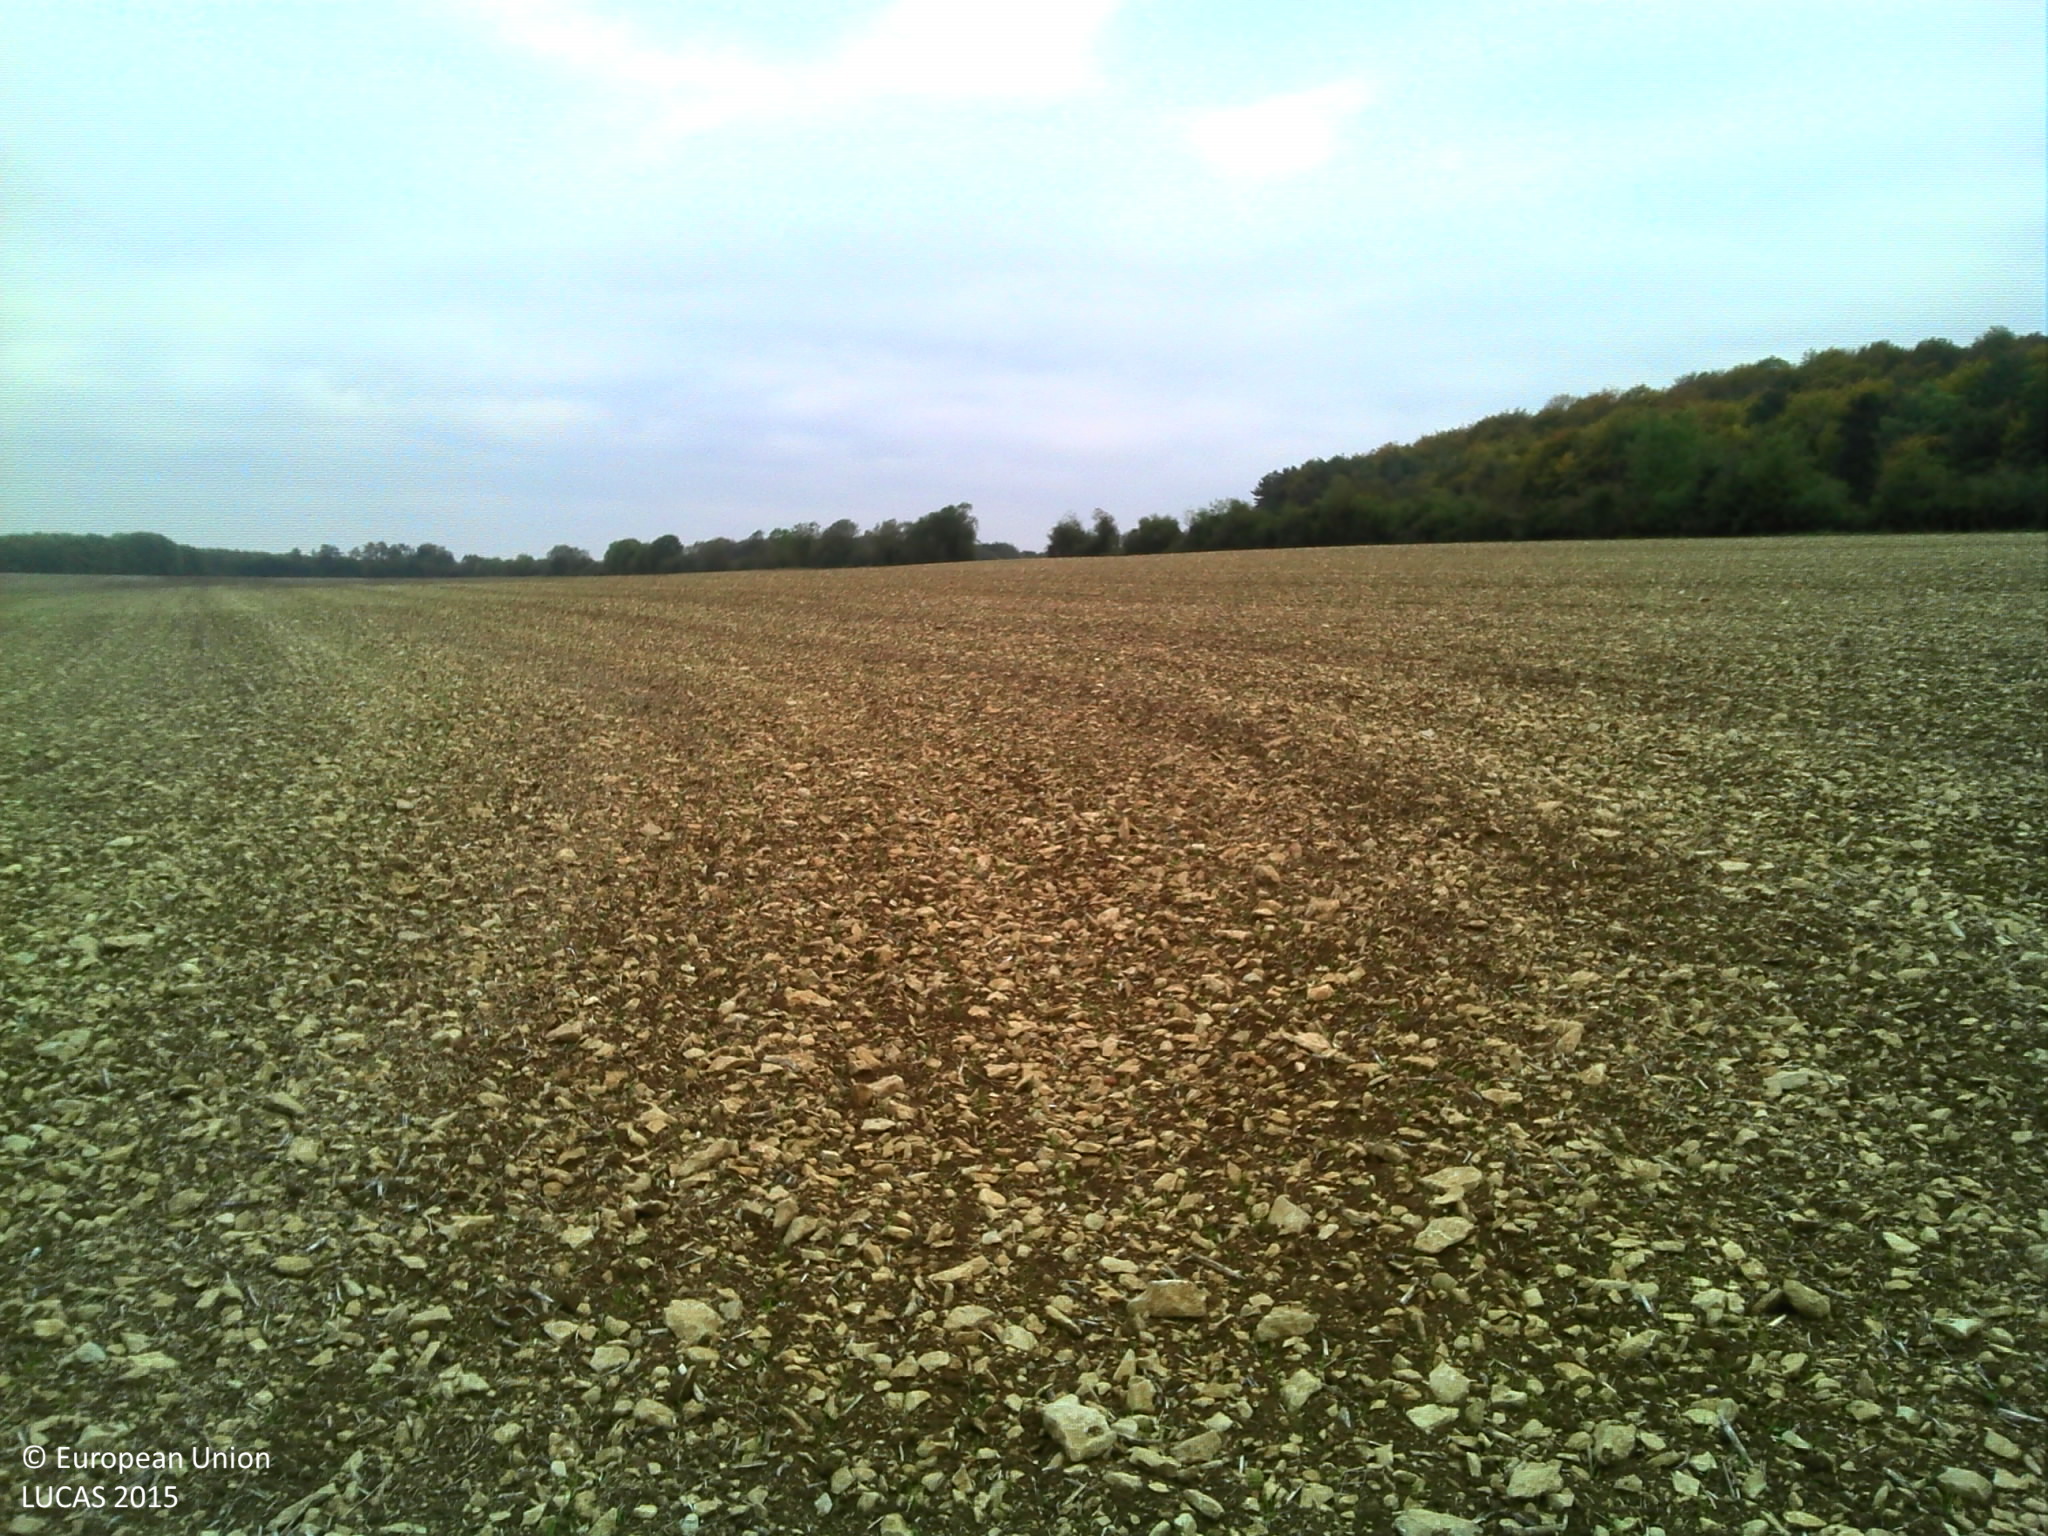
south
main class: Cropland
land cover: Common wheat
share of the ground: < 10 %
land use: Agriculture (excluding fallow land and kitchen gardens)
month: October
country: FR
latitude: 47.2227
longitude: 4.9162
